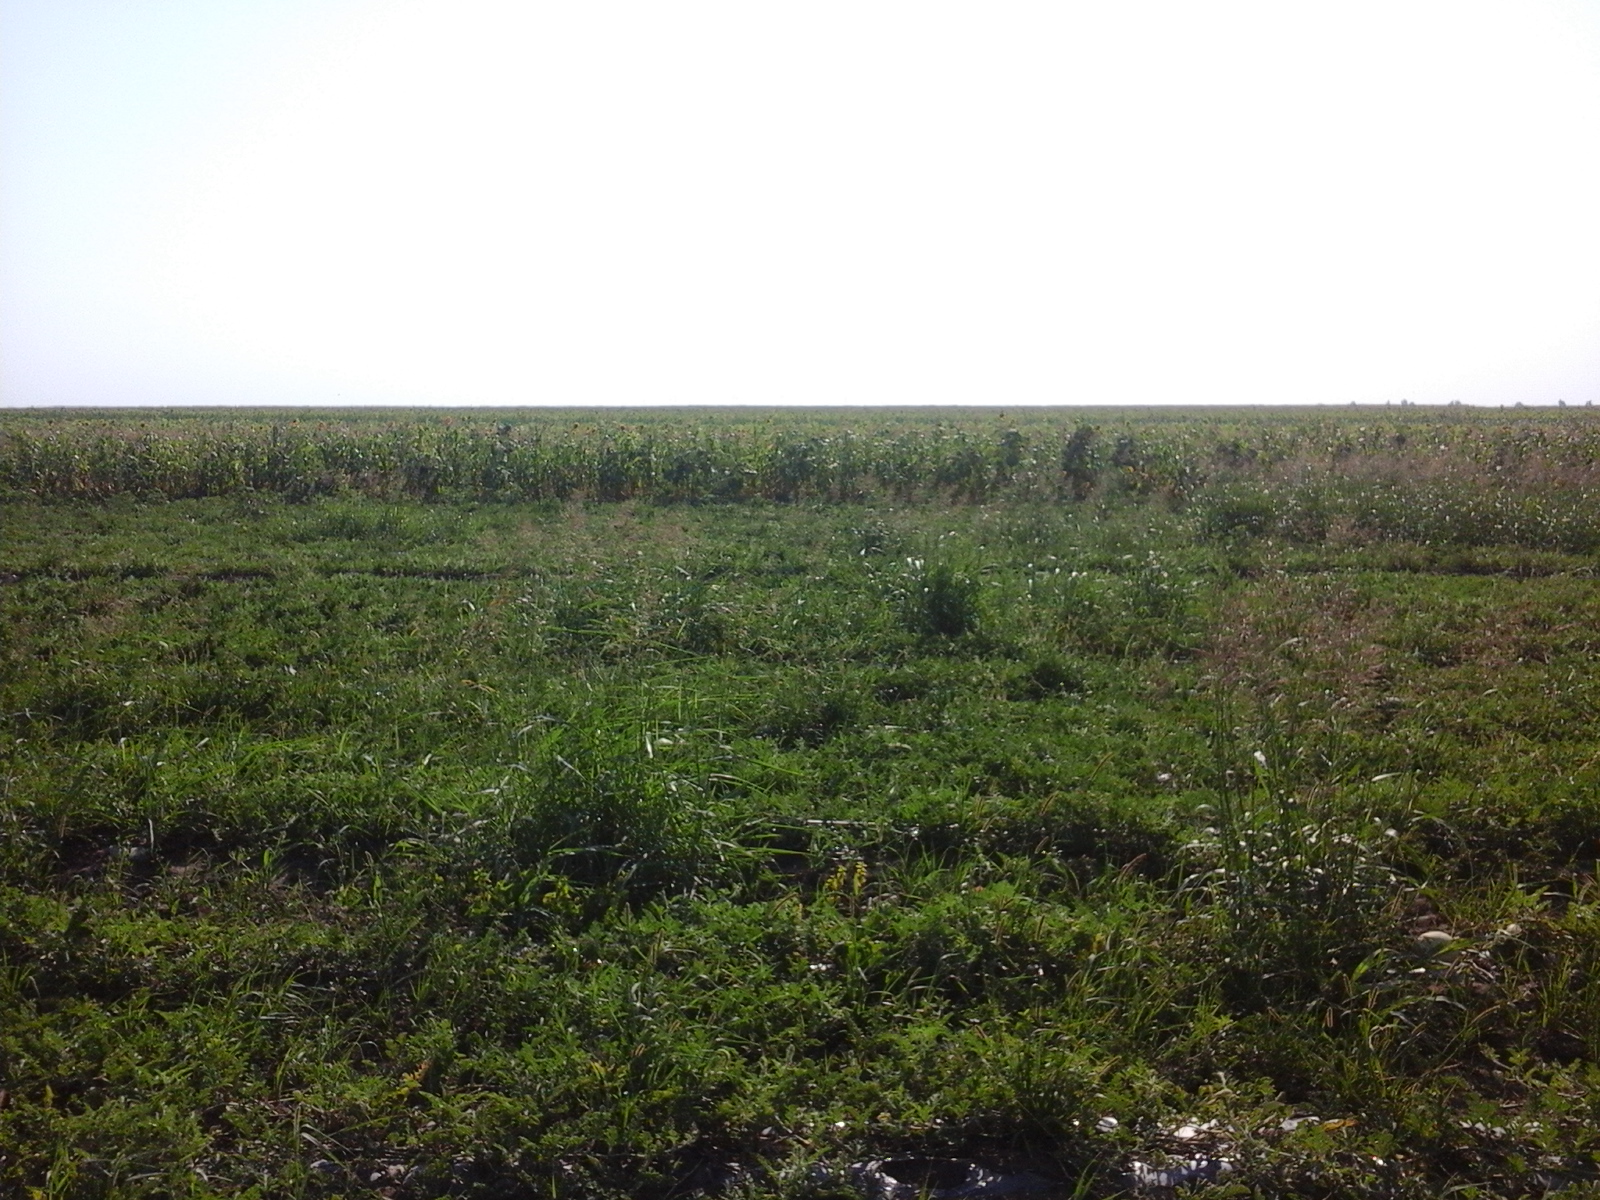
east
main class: Cropland
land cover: Other fresh vegetables
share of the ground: > 75 %
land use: Agriculture (excluding fallow land and kitchen gardens)
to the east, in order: Other fresh vegetables; Tracks; Other fresh vegetables; Sunflower; Maize; Sunflower; Maize
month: August
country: RO
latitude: 45.8382
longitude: 27.5790
